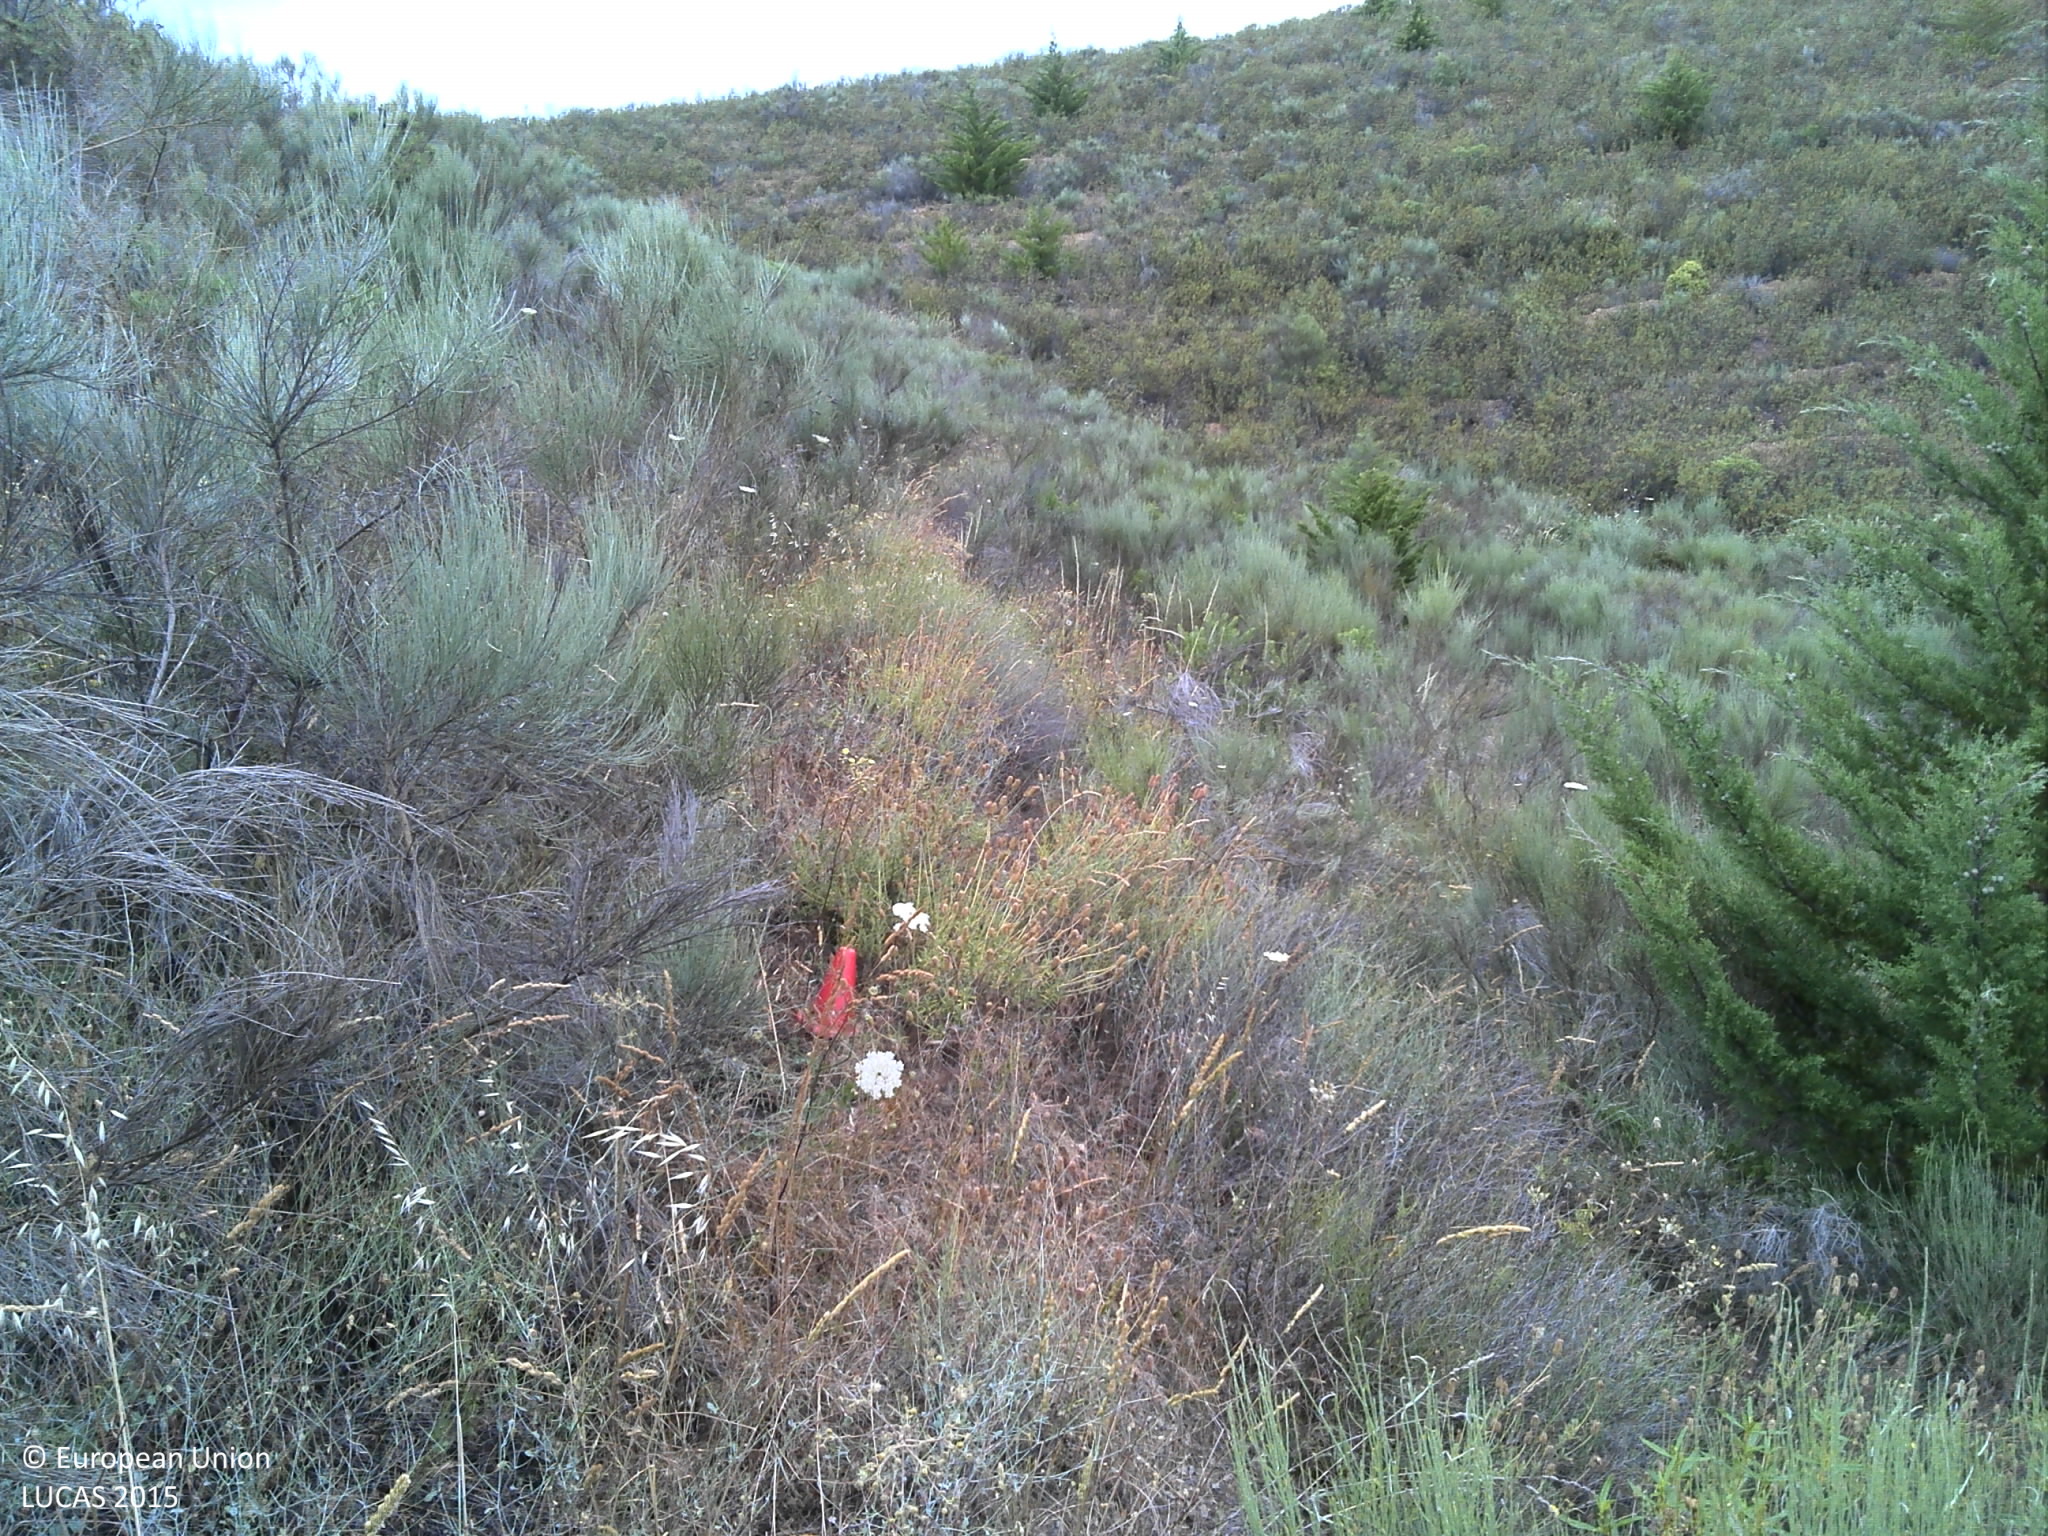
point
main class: Shrubland
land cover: Shrubland with sparse tree cover
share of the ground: > 75 %
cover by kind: shrubs 95 %, coniferous forest trees 5 %
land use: Abandoned areas
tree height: < 5 m
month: June
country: PT
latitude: 41.2855
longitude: -6.9578
